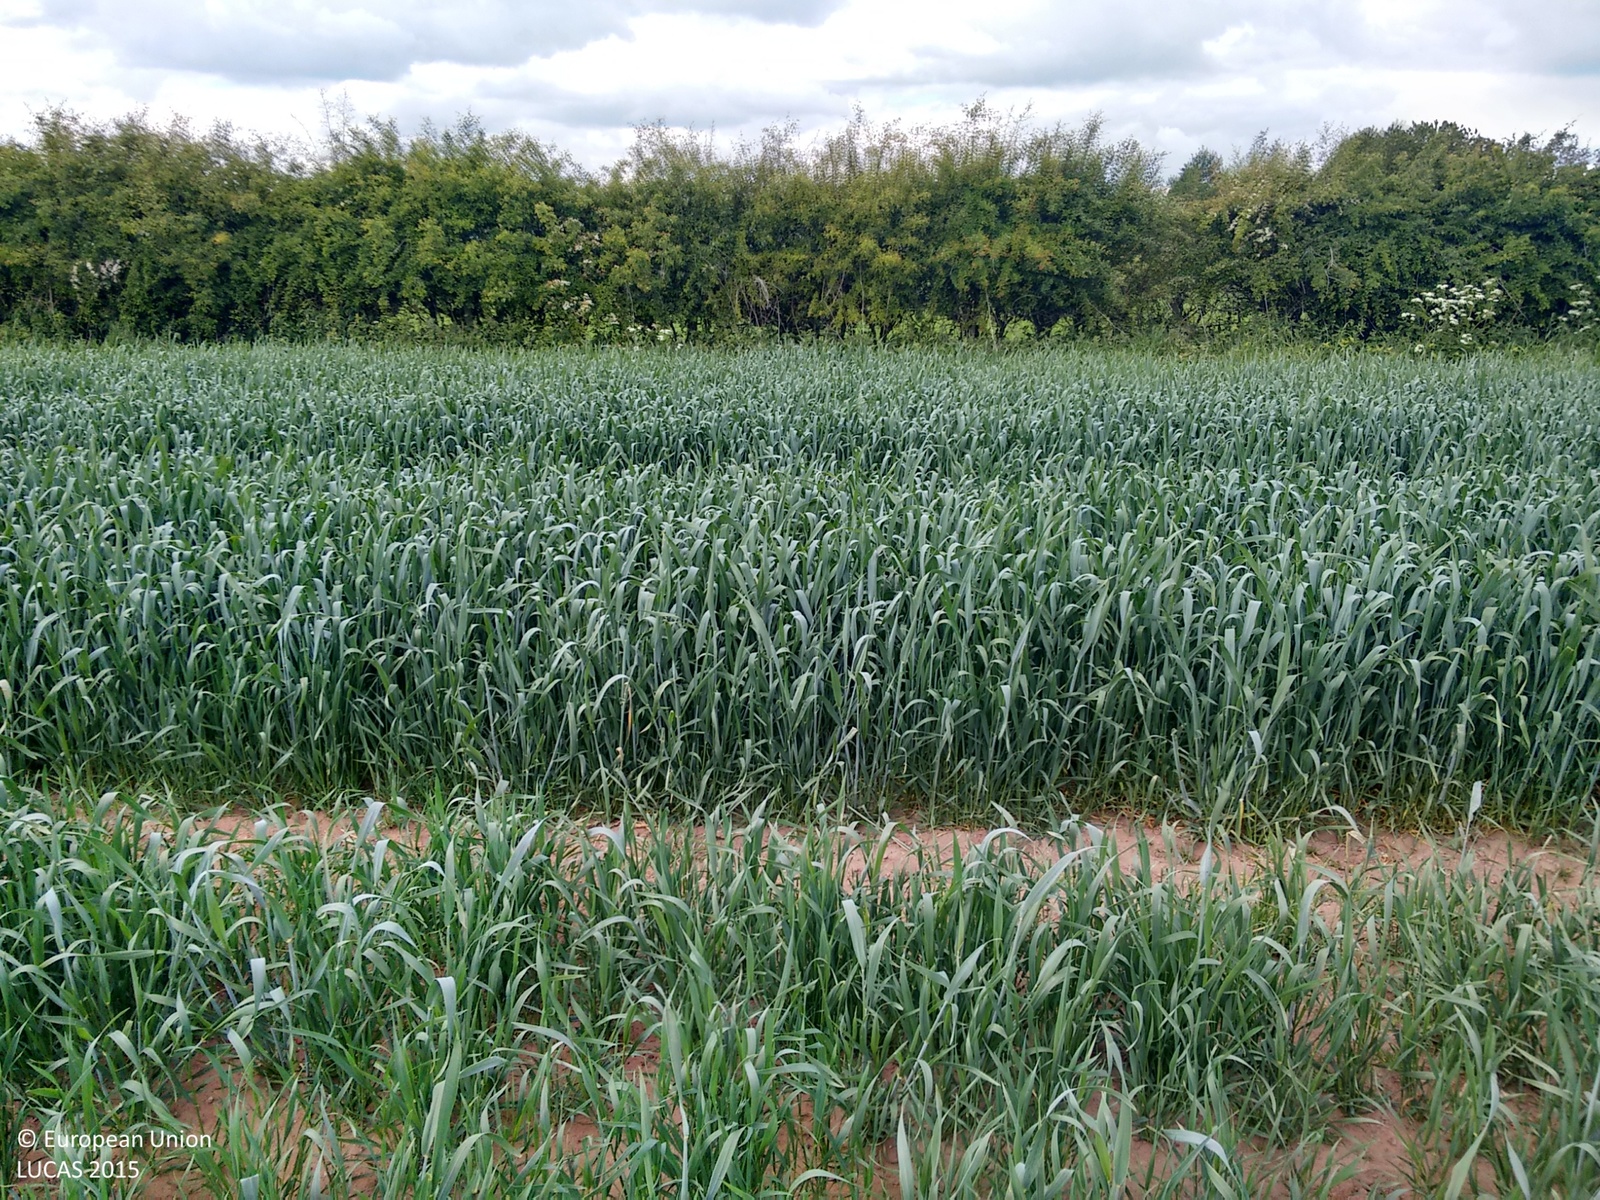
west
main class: Cropland
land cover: Common wheat
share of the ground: > 75 %
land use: Agriculture (excluding fallow land and kitchen gardens)
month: June
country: GB
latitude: 54.2405
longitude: -1.4179
